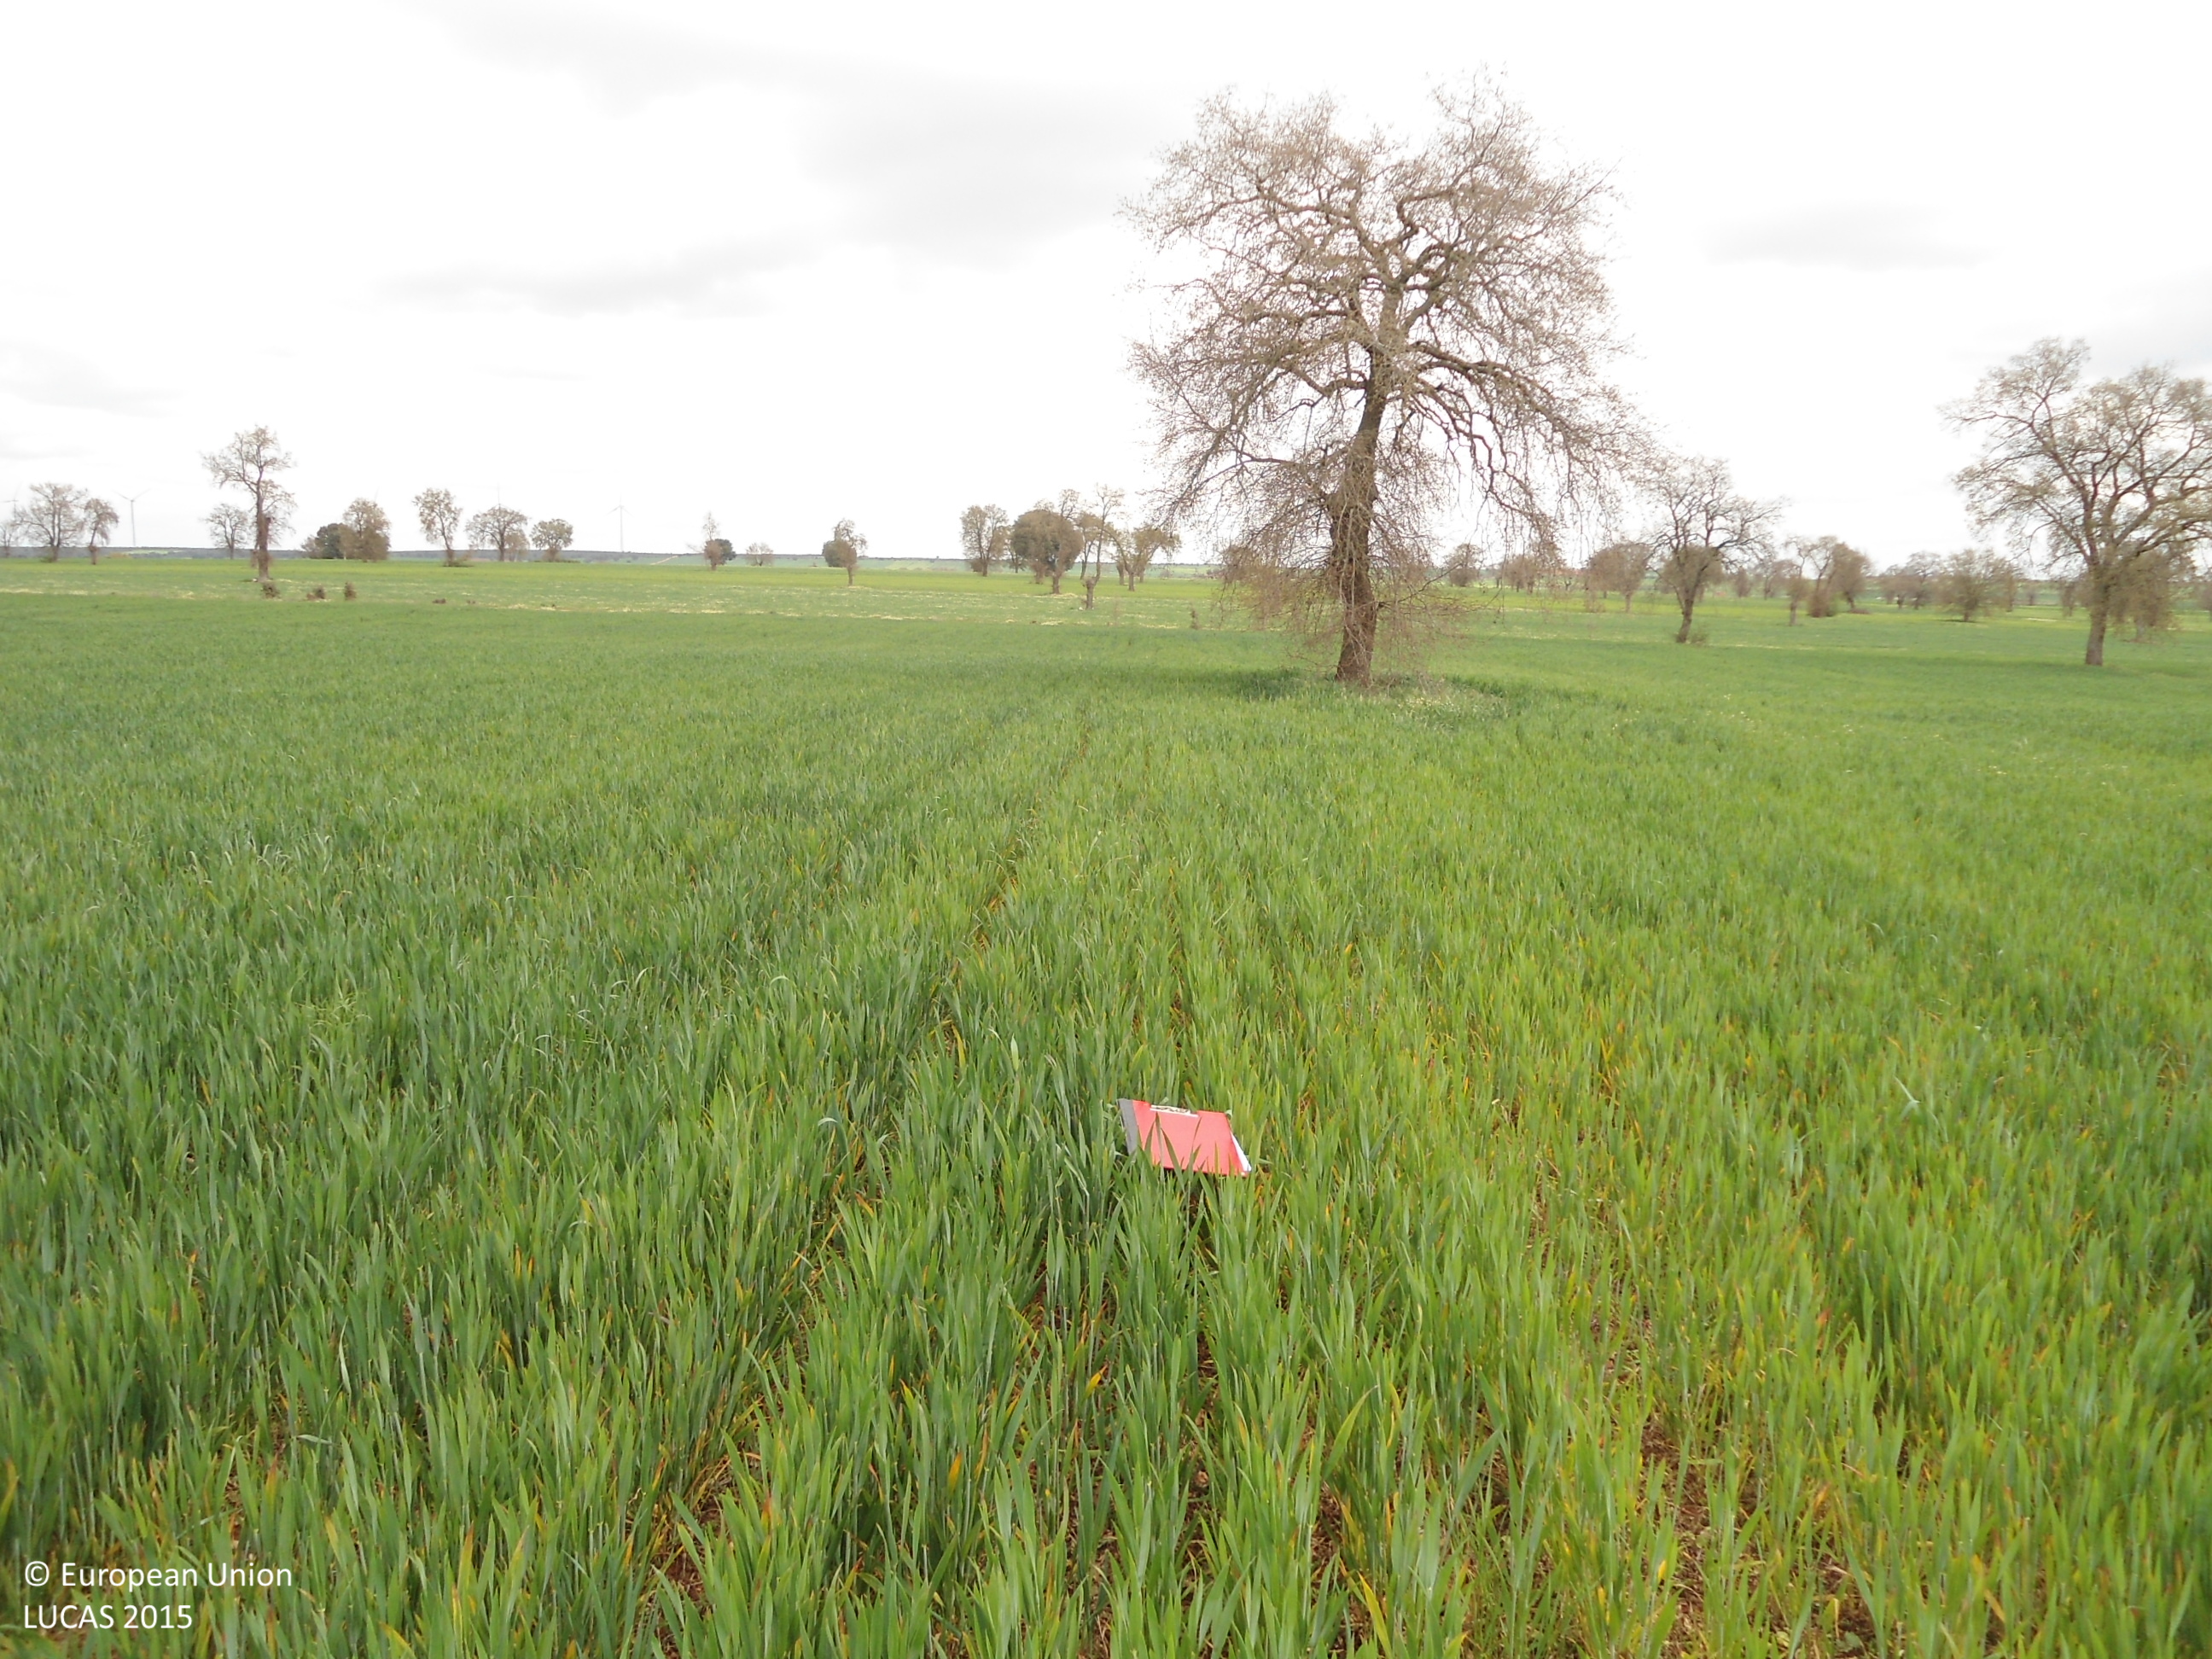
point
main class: Cropland
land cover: Common wheat
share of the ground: > 75 %
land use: Agriculture (excluding fallow land and kitchen gardens)
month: April
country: ES
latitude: 41.6138
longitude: -5.8712
